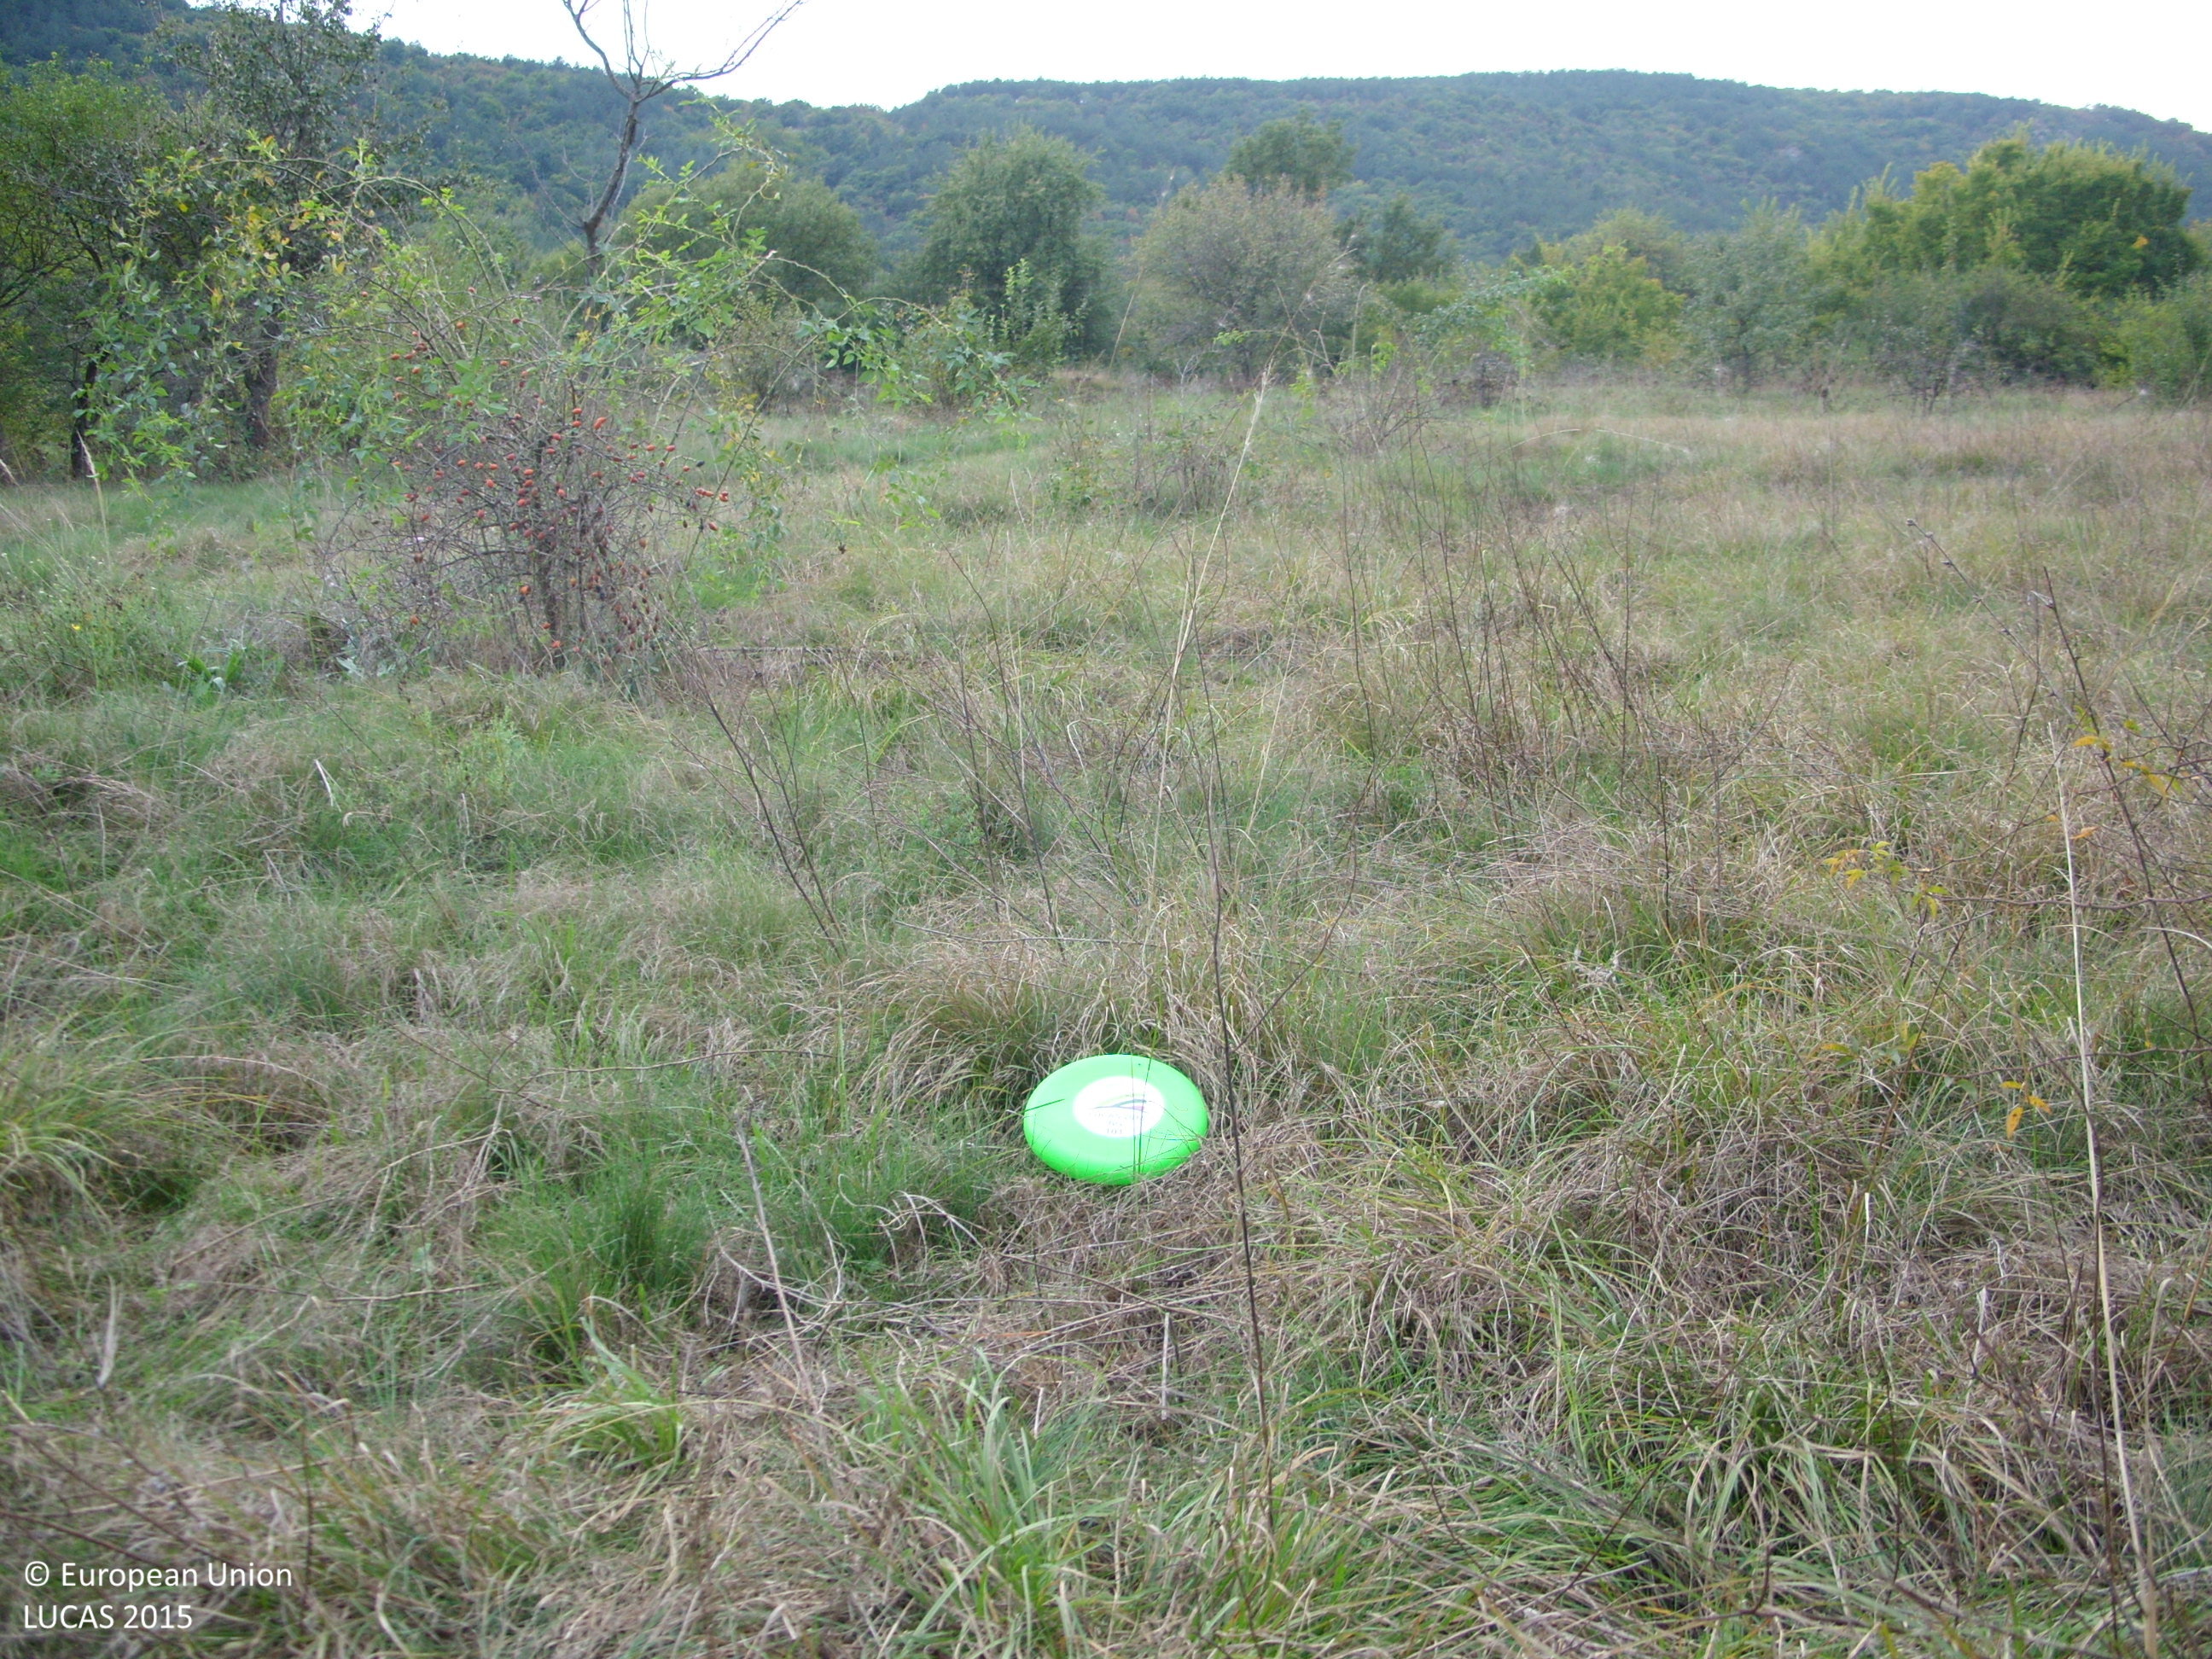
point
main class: Grassland
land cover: Grassland with sparse tree/shrub cover
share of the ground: > 75 %
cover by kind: herbaceous plants 90 %, broadleaved forest trees 5 %, shrubs 5 %
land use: Agriculture (excluding fallow land and kitchen gardens)
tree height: < 5 m
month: October
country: BG
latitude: 42.5489
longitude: 24.8047
